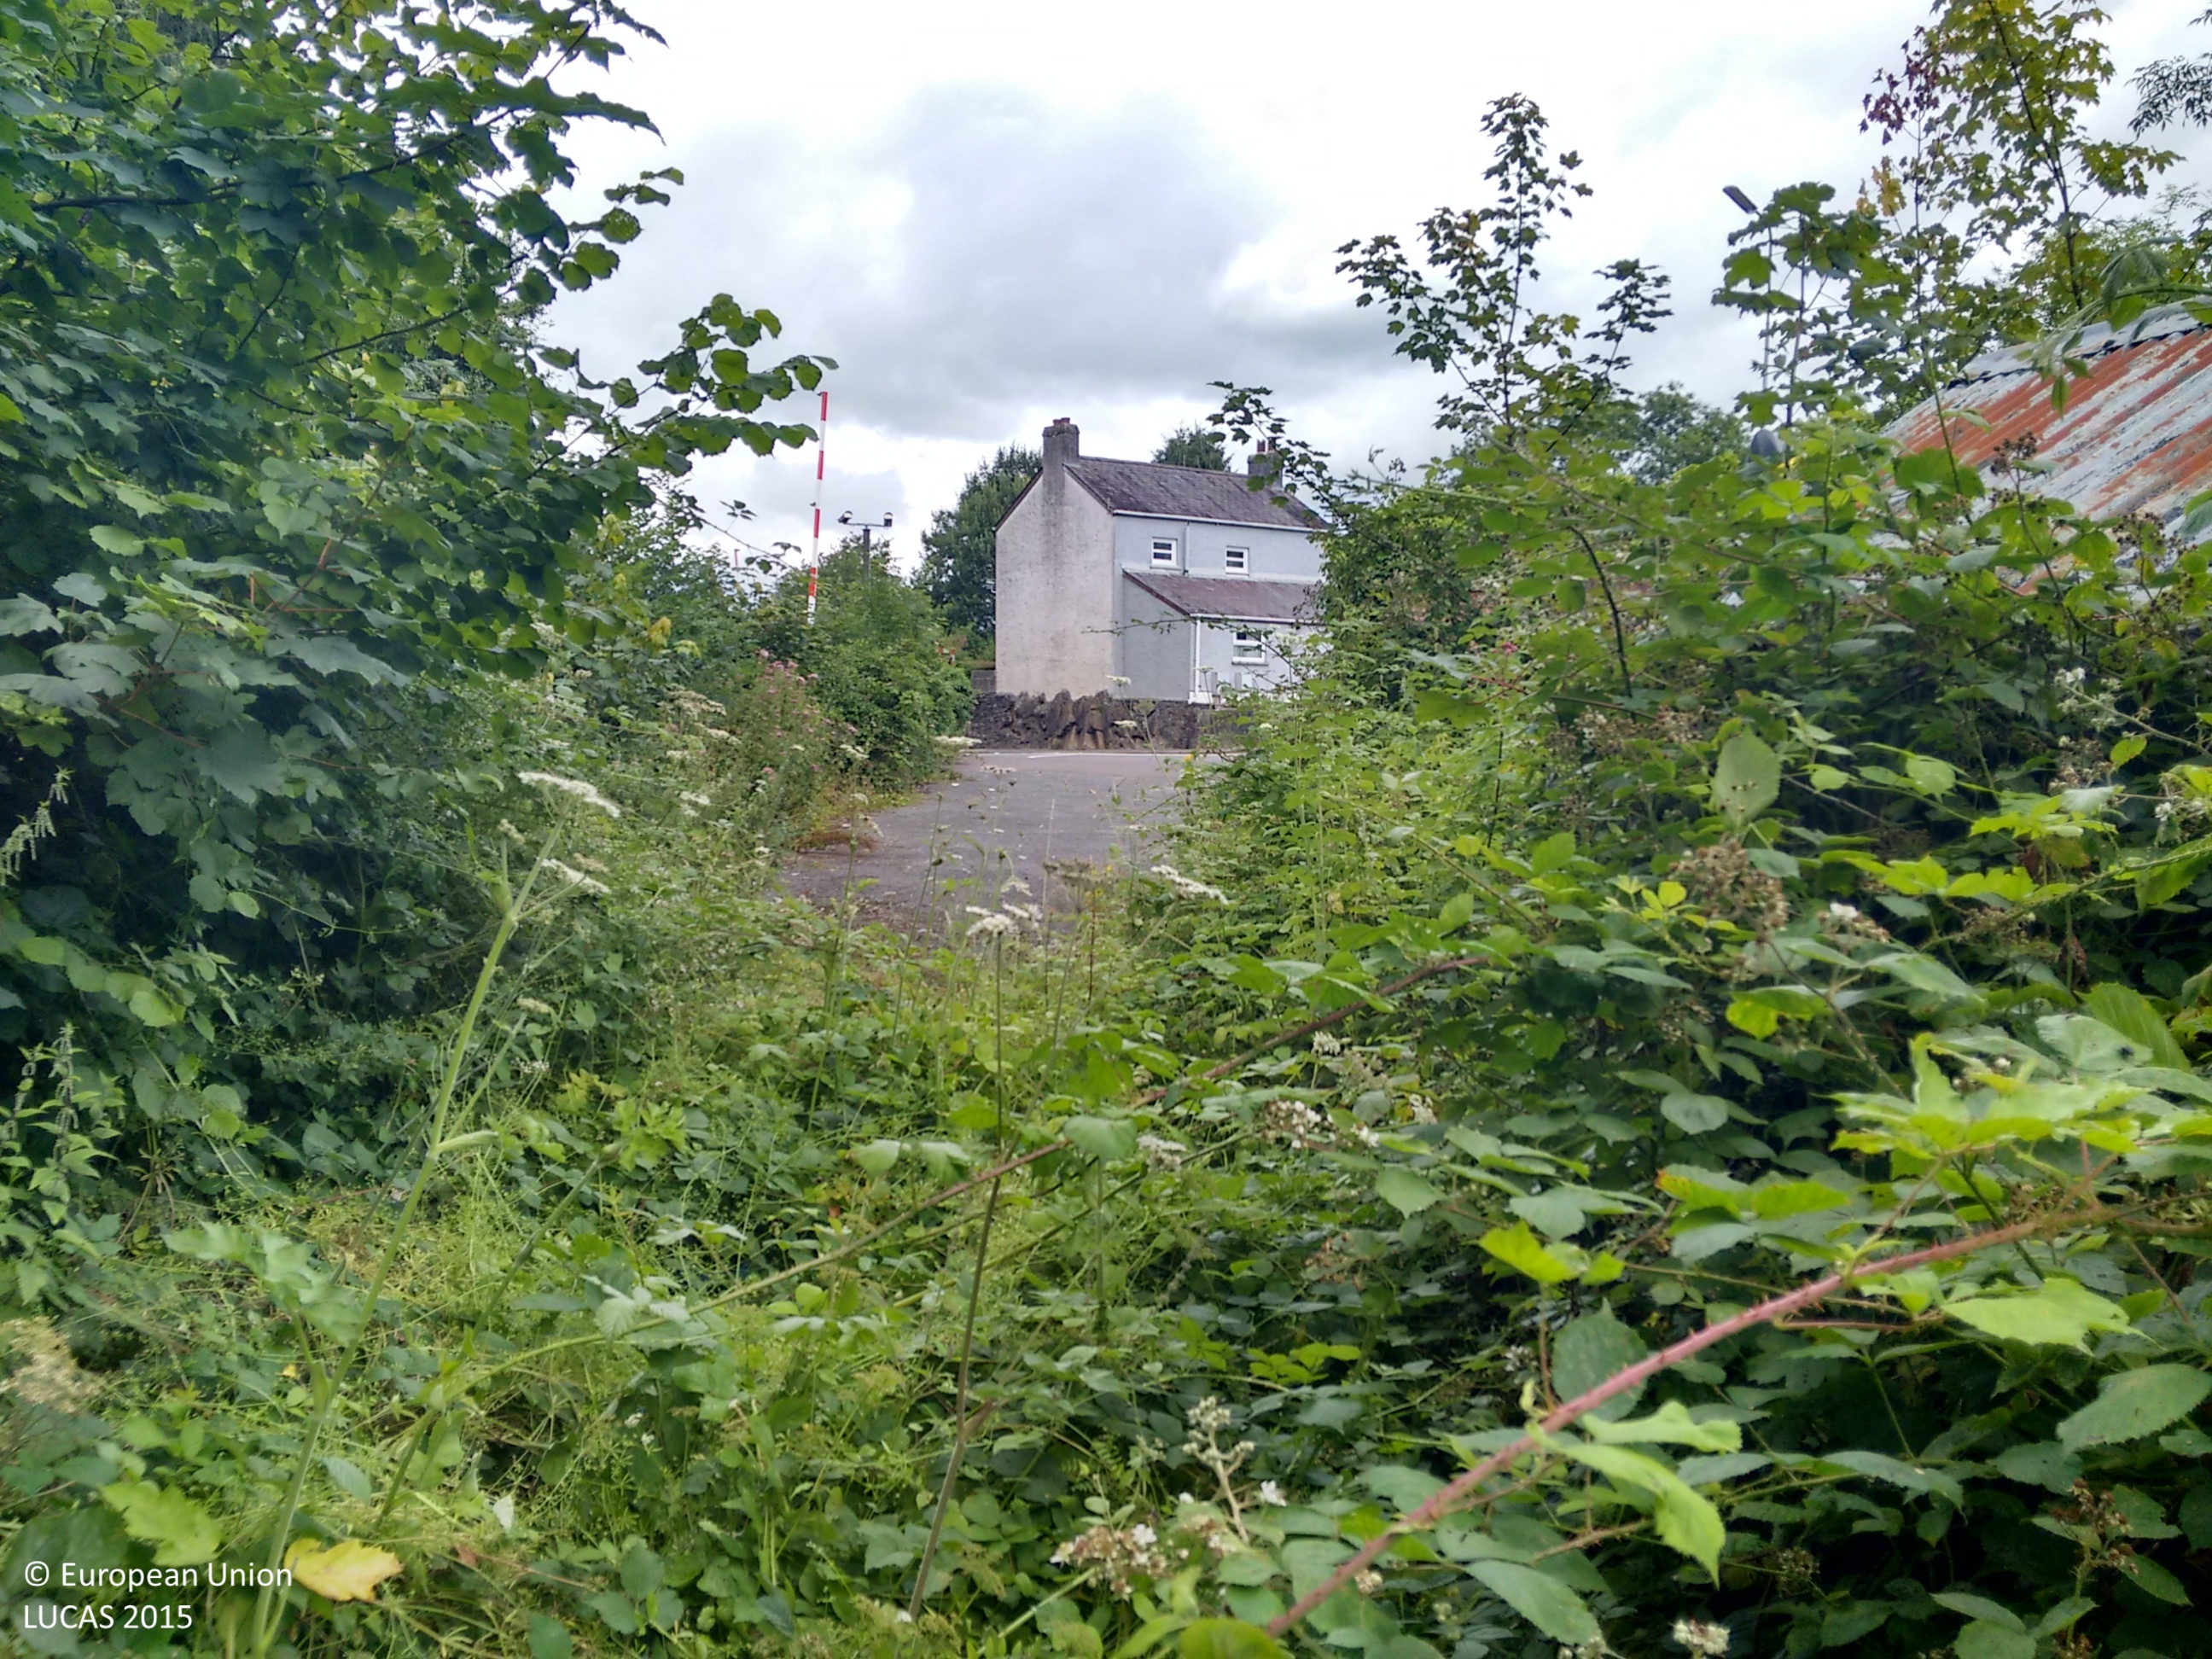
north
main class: Woodland
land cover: Broadleaved woodland
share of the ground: > 75 %
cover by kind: broadleaved forest trees 100 %
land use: Semi-natural and natural areas not in use
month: July
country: GB
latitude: 51.8717
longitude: -3.9942
